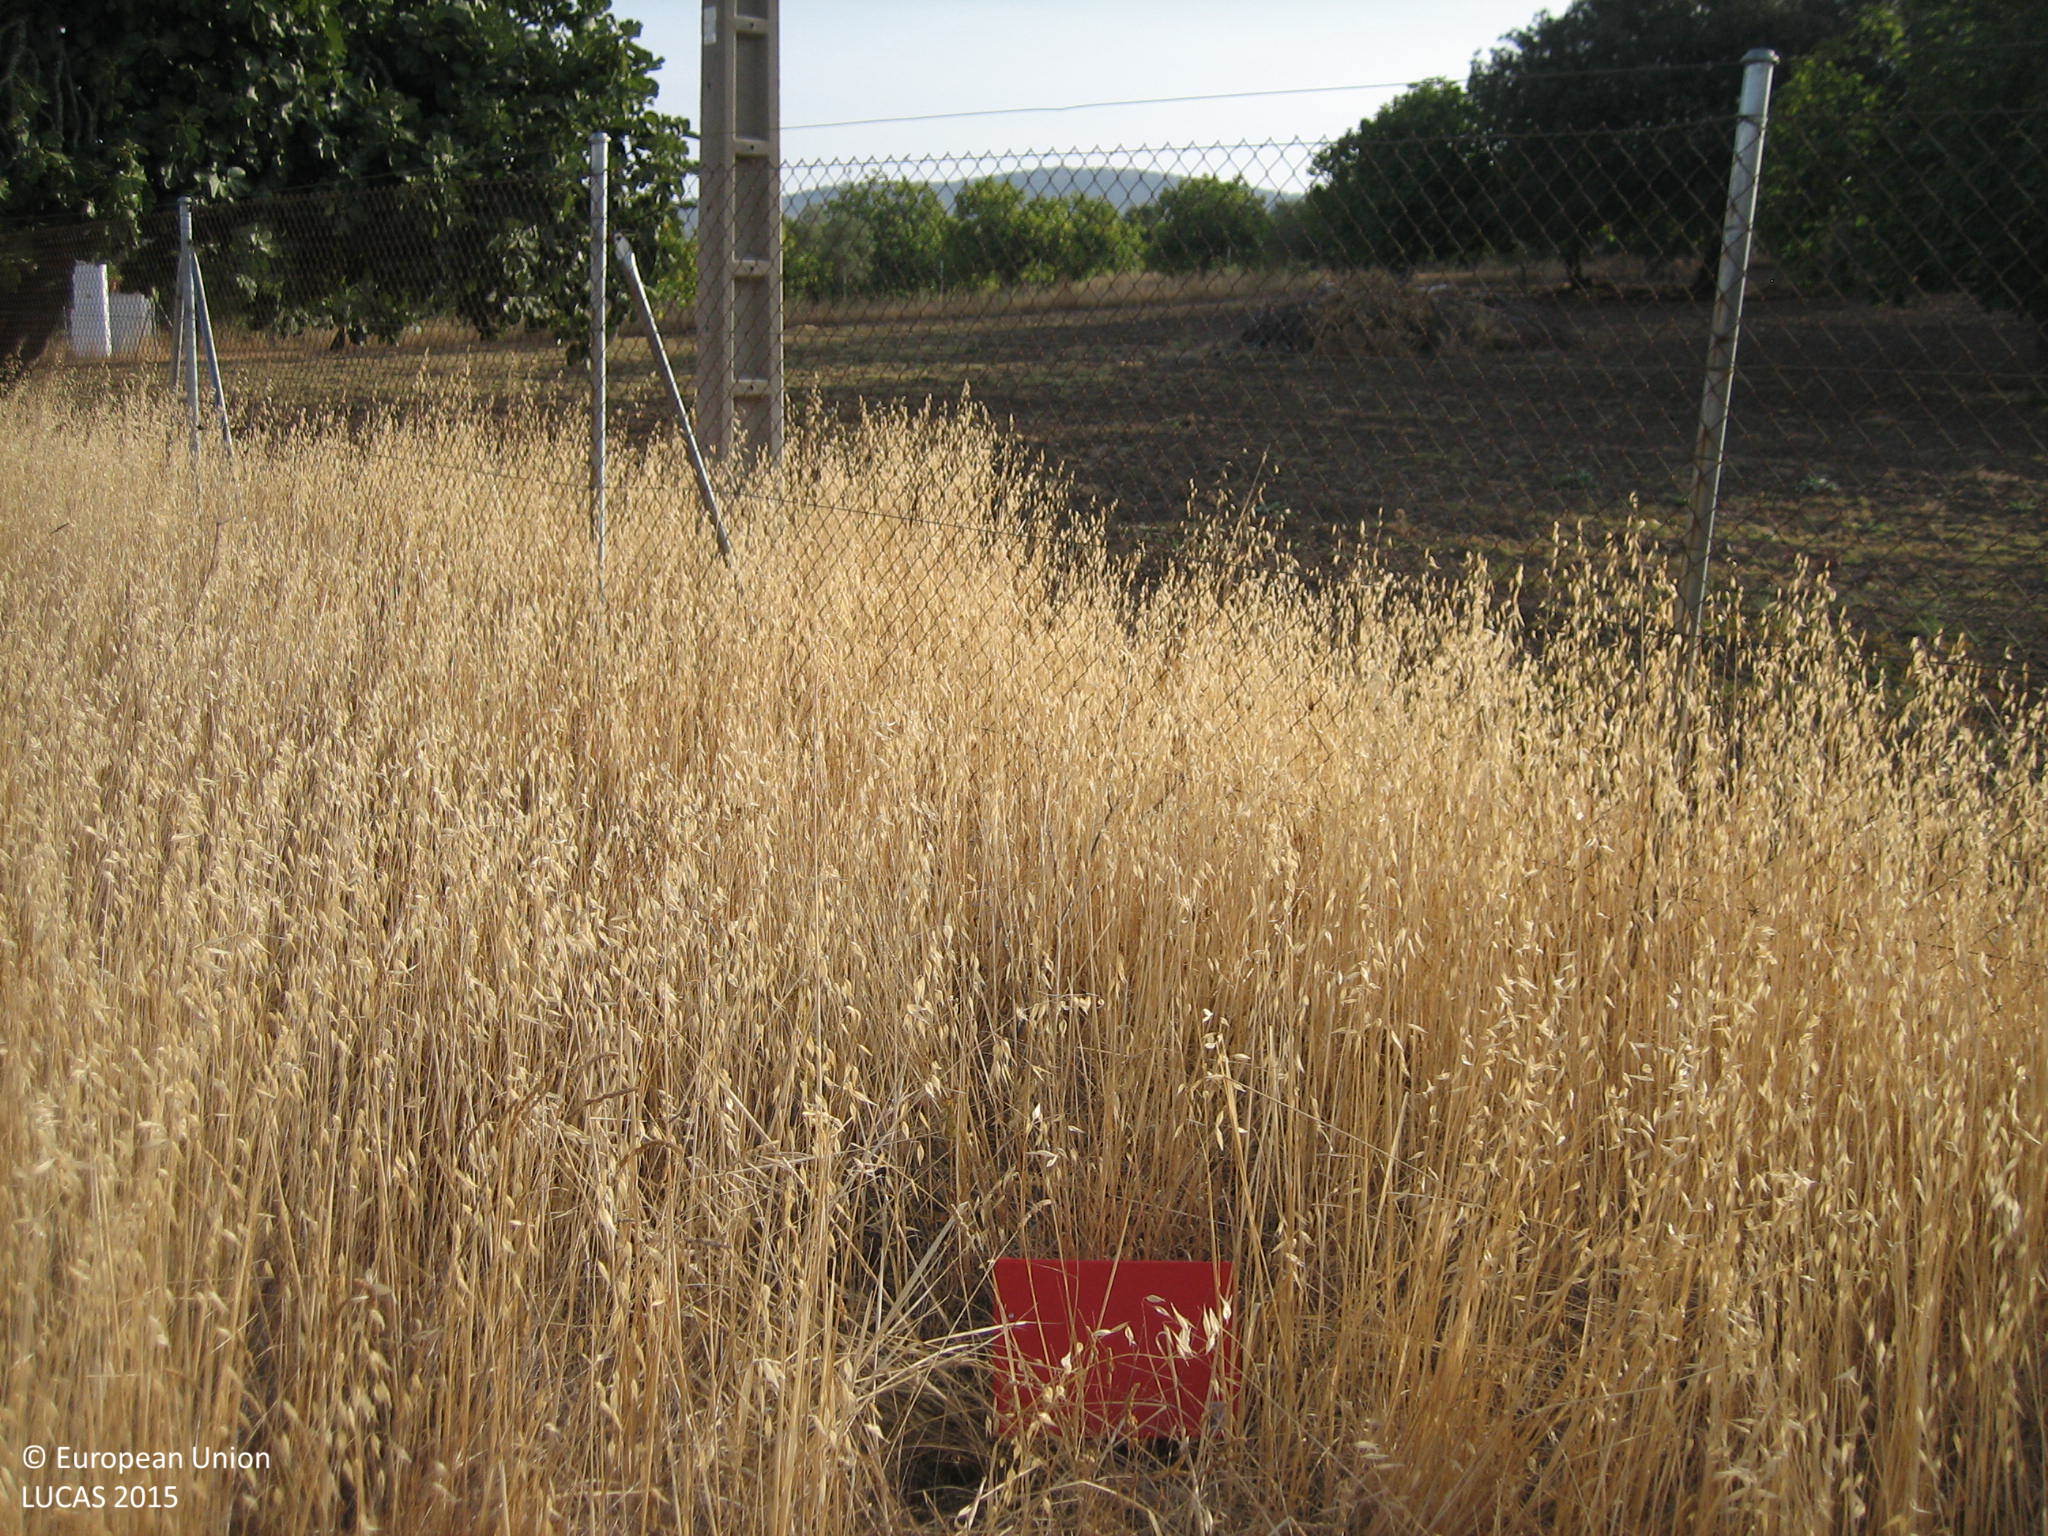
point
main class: Grassland
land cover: Grassland without tree/shrub cover
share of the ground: > 75 %
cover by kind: herbaceous plants 100 %
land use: Semi-natural and natural areas not in use
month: September
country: ES
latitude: 38.4837
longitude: -6.8546
